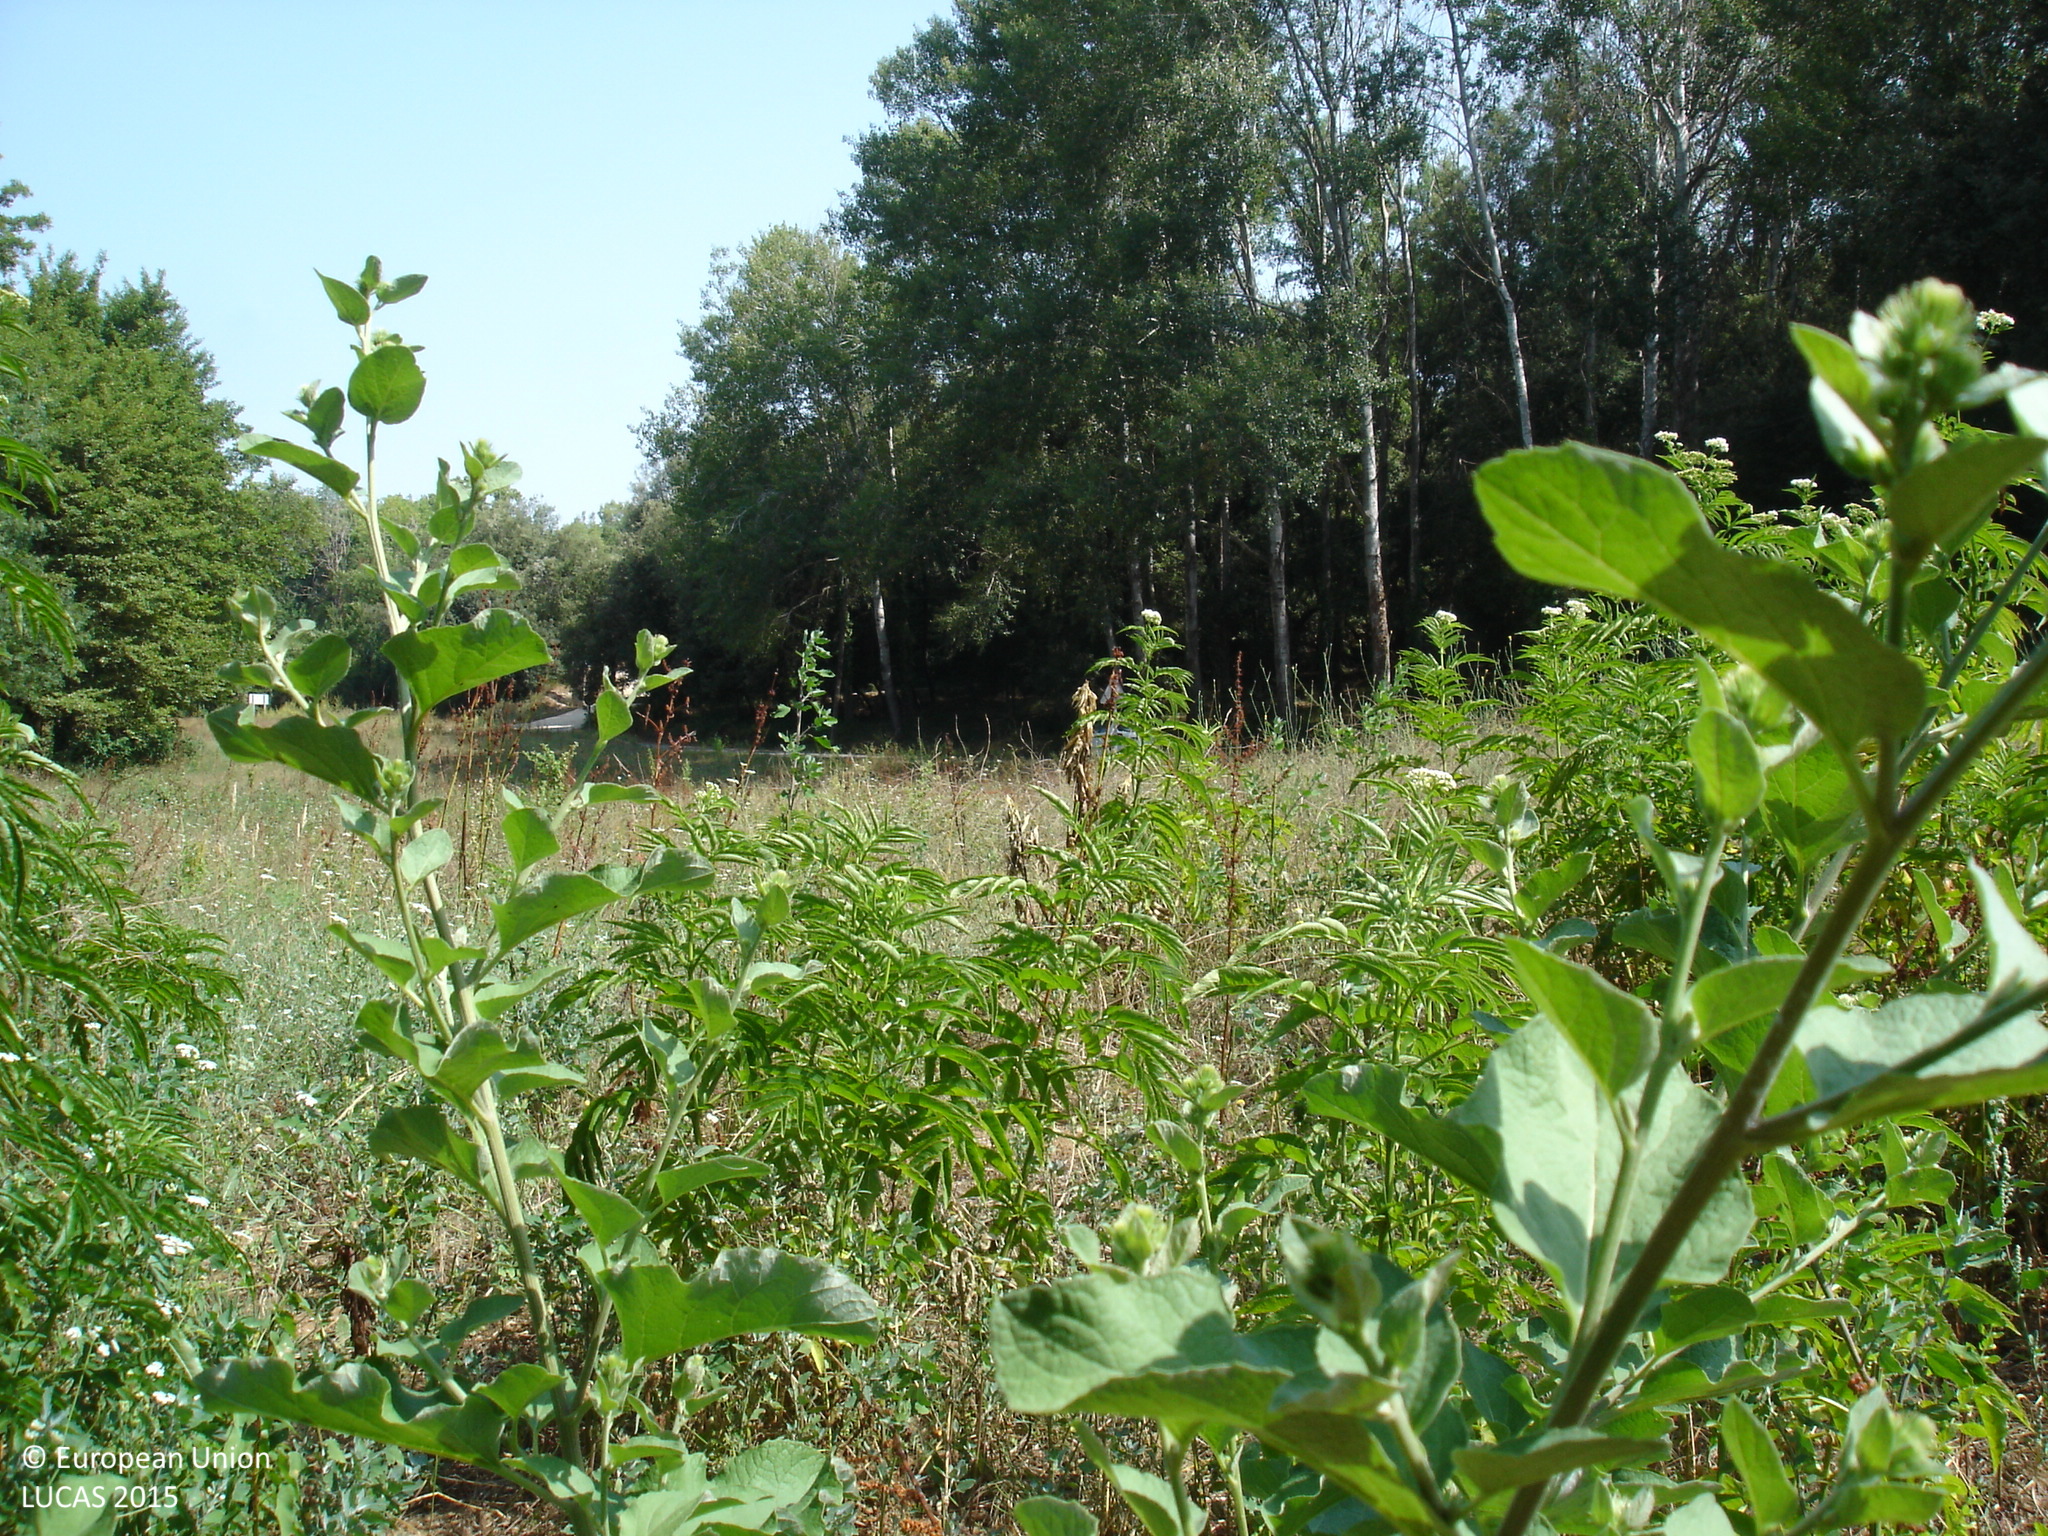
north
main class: Grassland
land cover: Grassland with sparse tree/shrub cover
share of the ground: > 75 %
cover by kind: herbaceous plants 90 %, broadleaved forest trees 5 %, consolidated bare surface 5 %
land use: Semi-natural and natural areas not in use
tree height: > 5 m
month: July
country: ES
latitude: 41.9949
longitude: 3.0020
